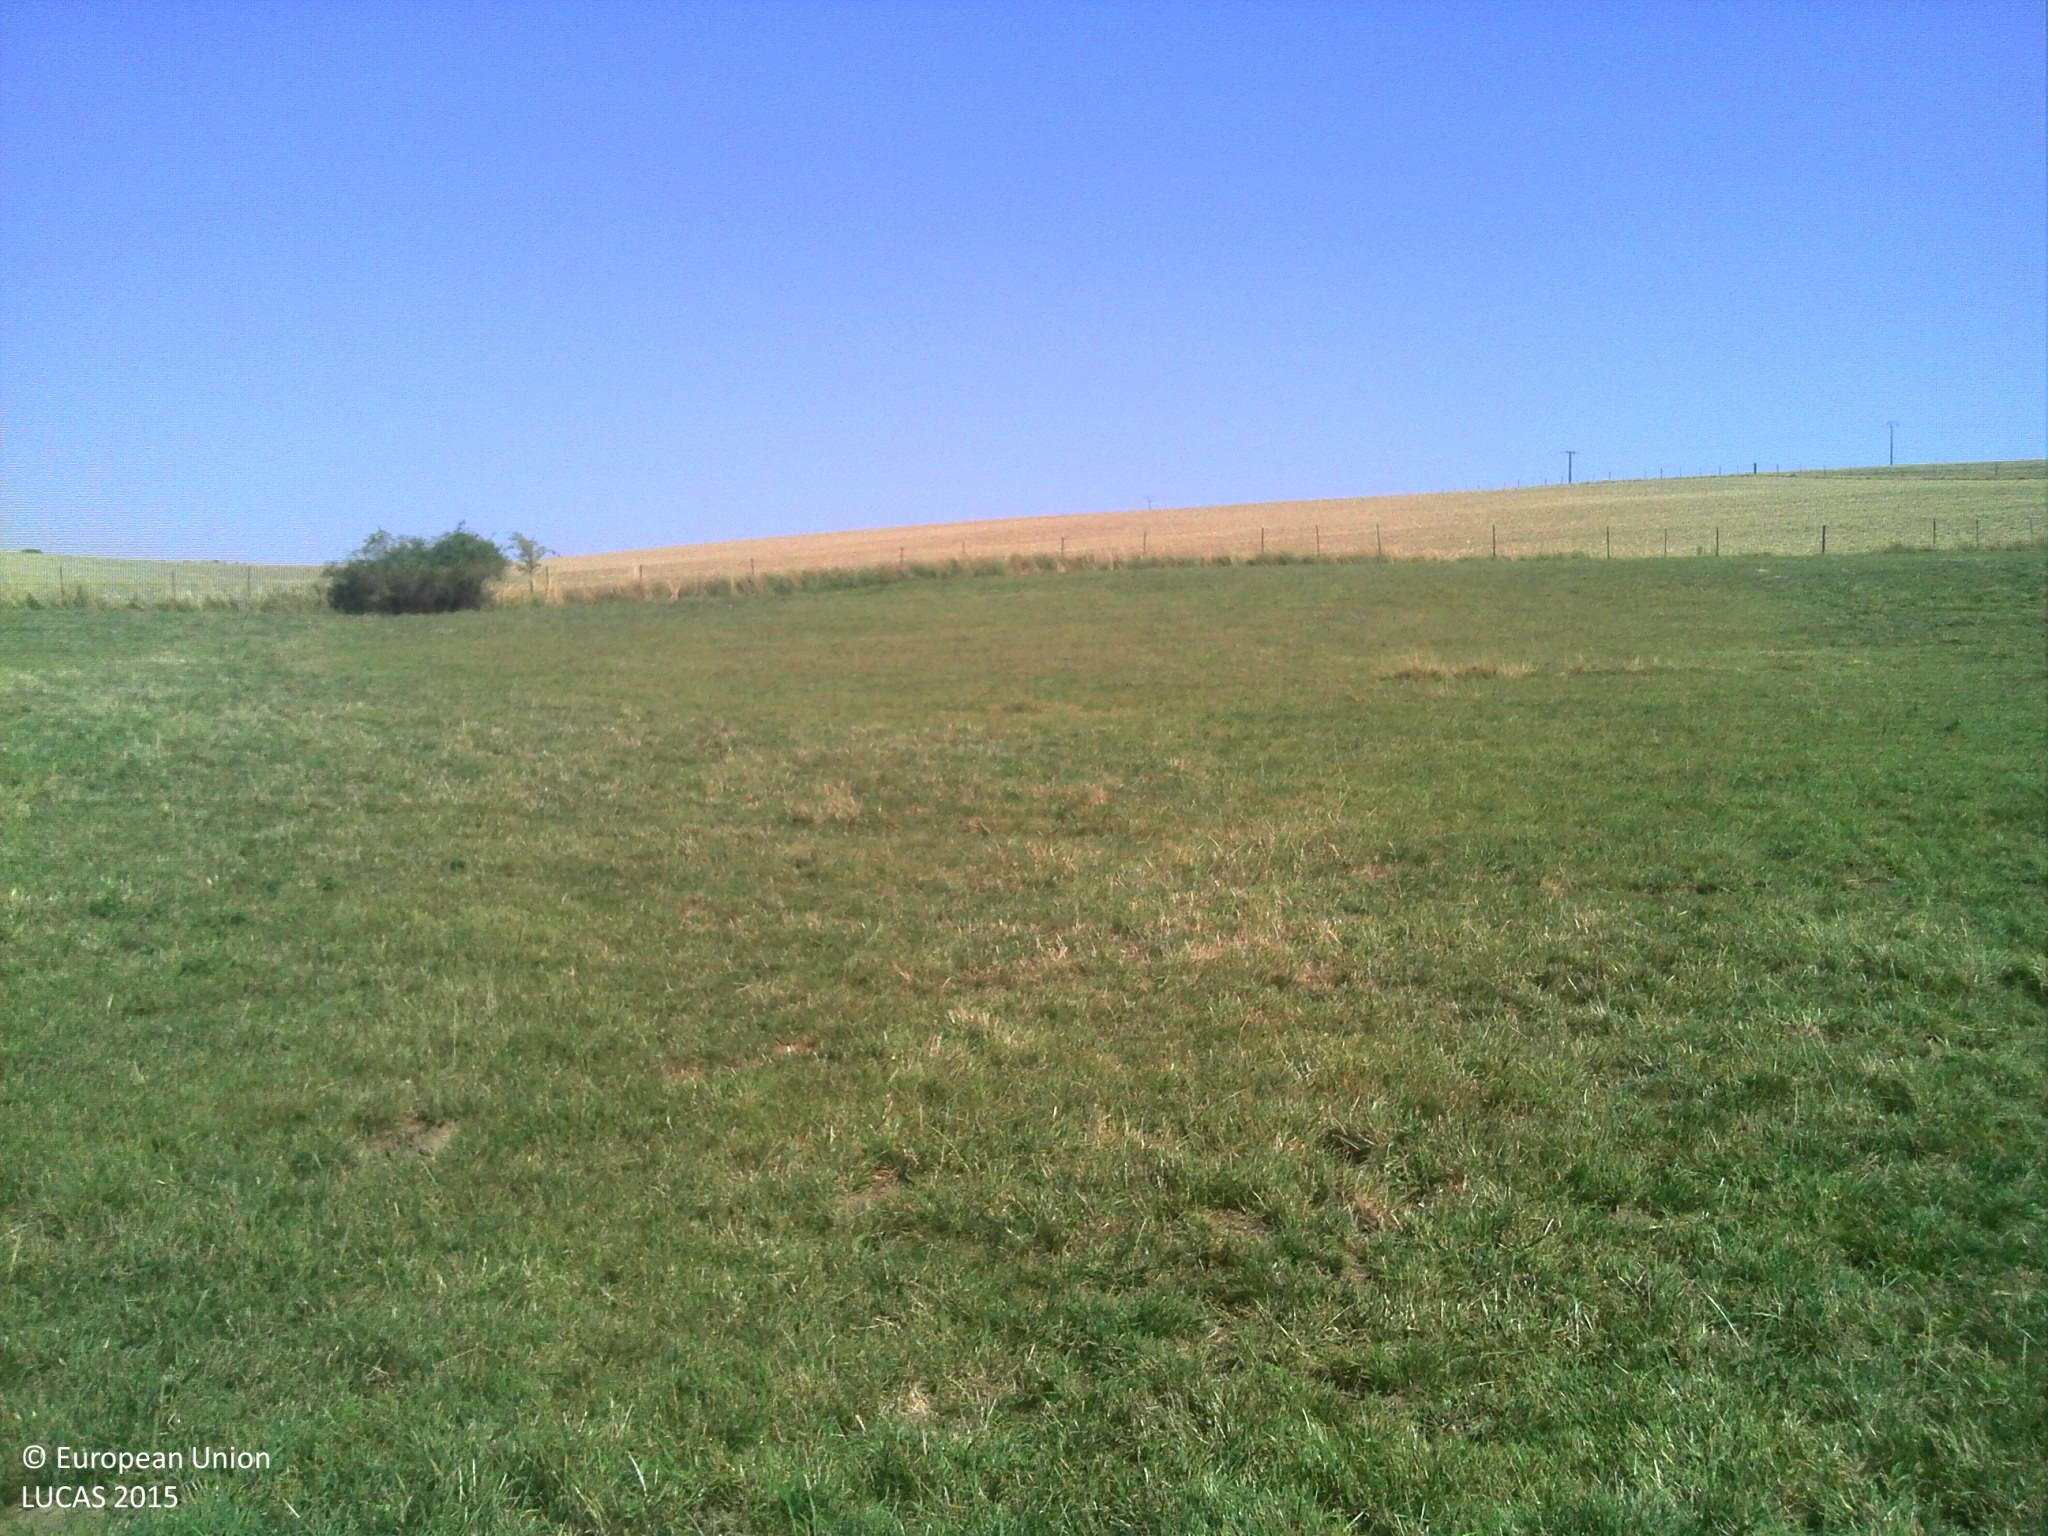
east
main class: Grassland
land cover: Grassland without tree/shrub cover
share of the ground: > 75 %
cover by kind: herbaceous plants 100 %
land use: Agriculture (excluding fallow land and kitchen gardens)
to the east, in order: Grassland without tree/shrub cover; Fences; Other bare soil
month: August
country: FR
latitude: 49.2881
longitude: 5.1447
